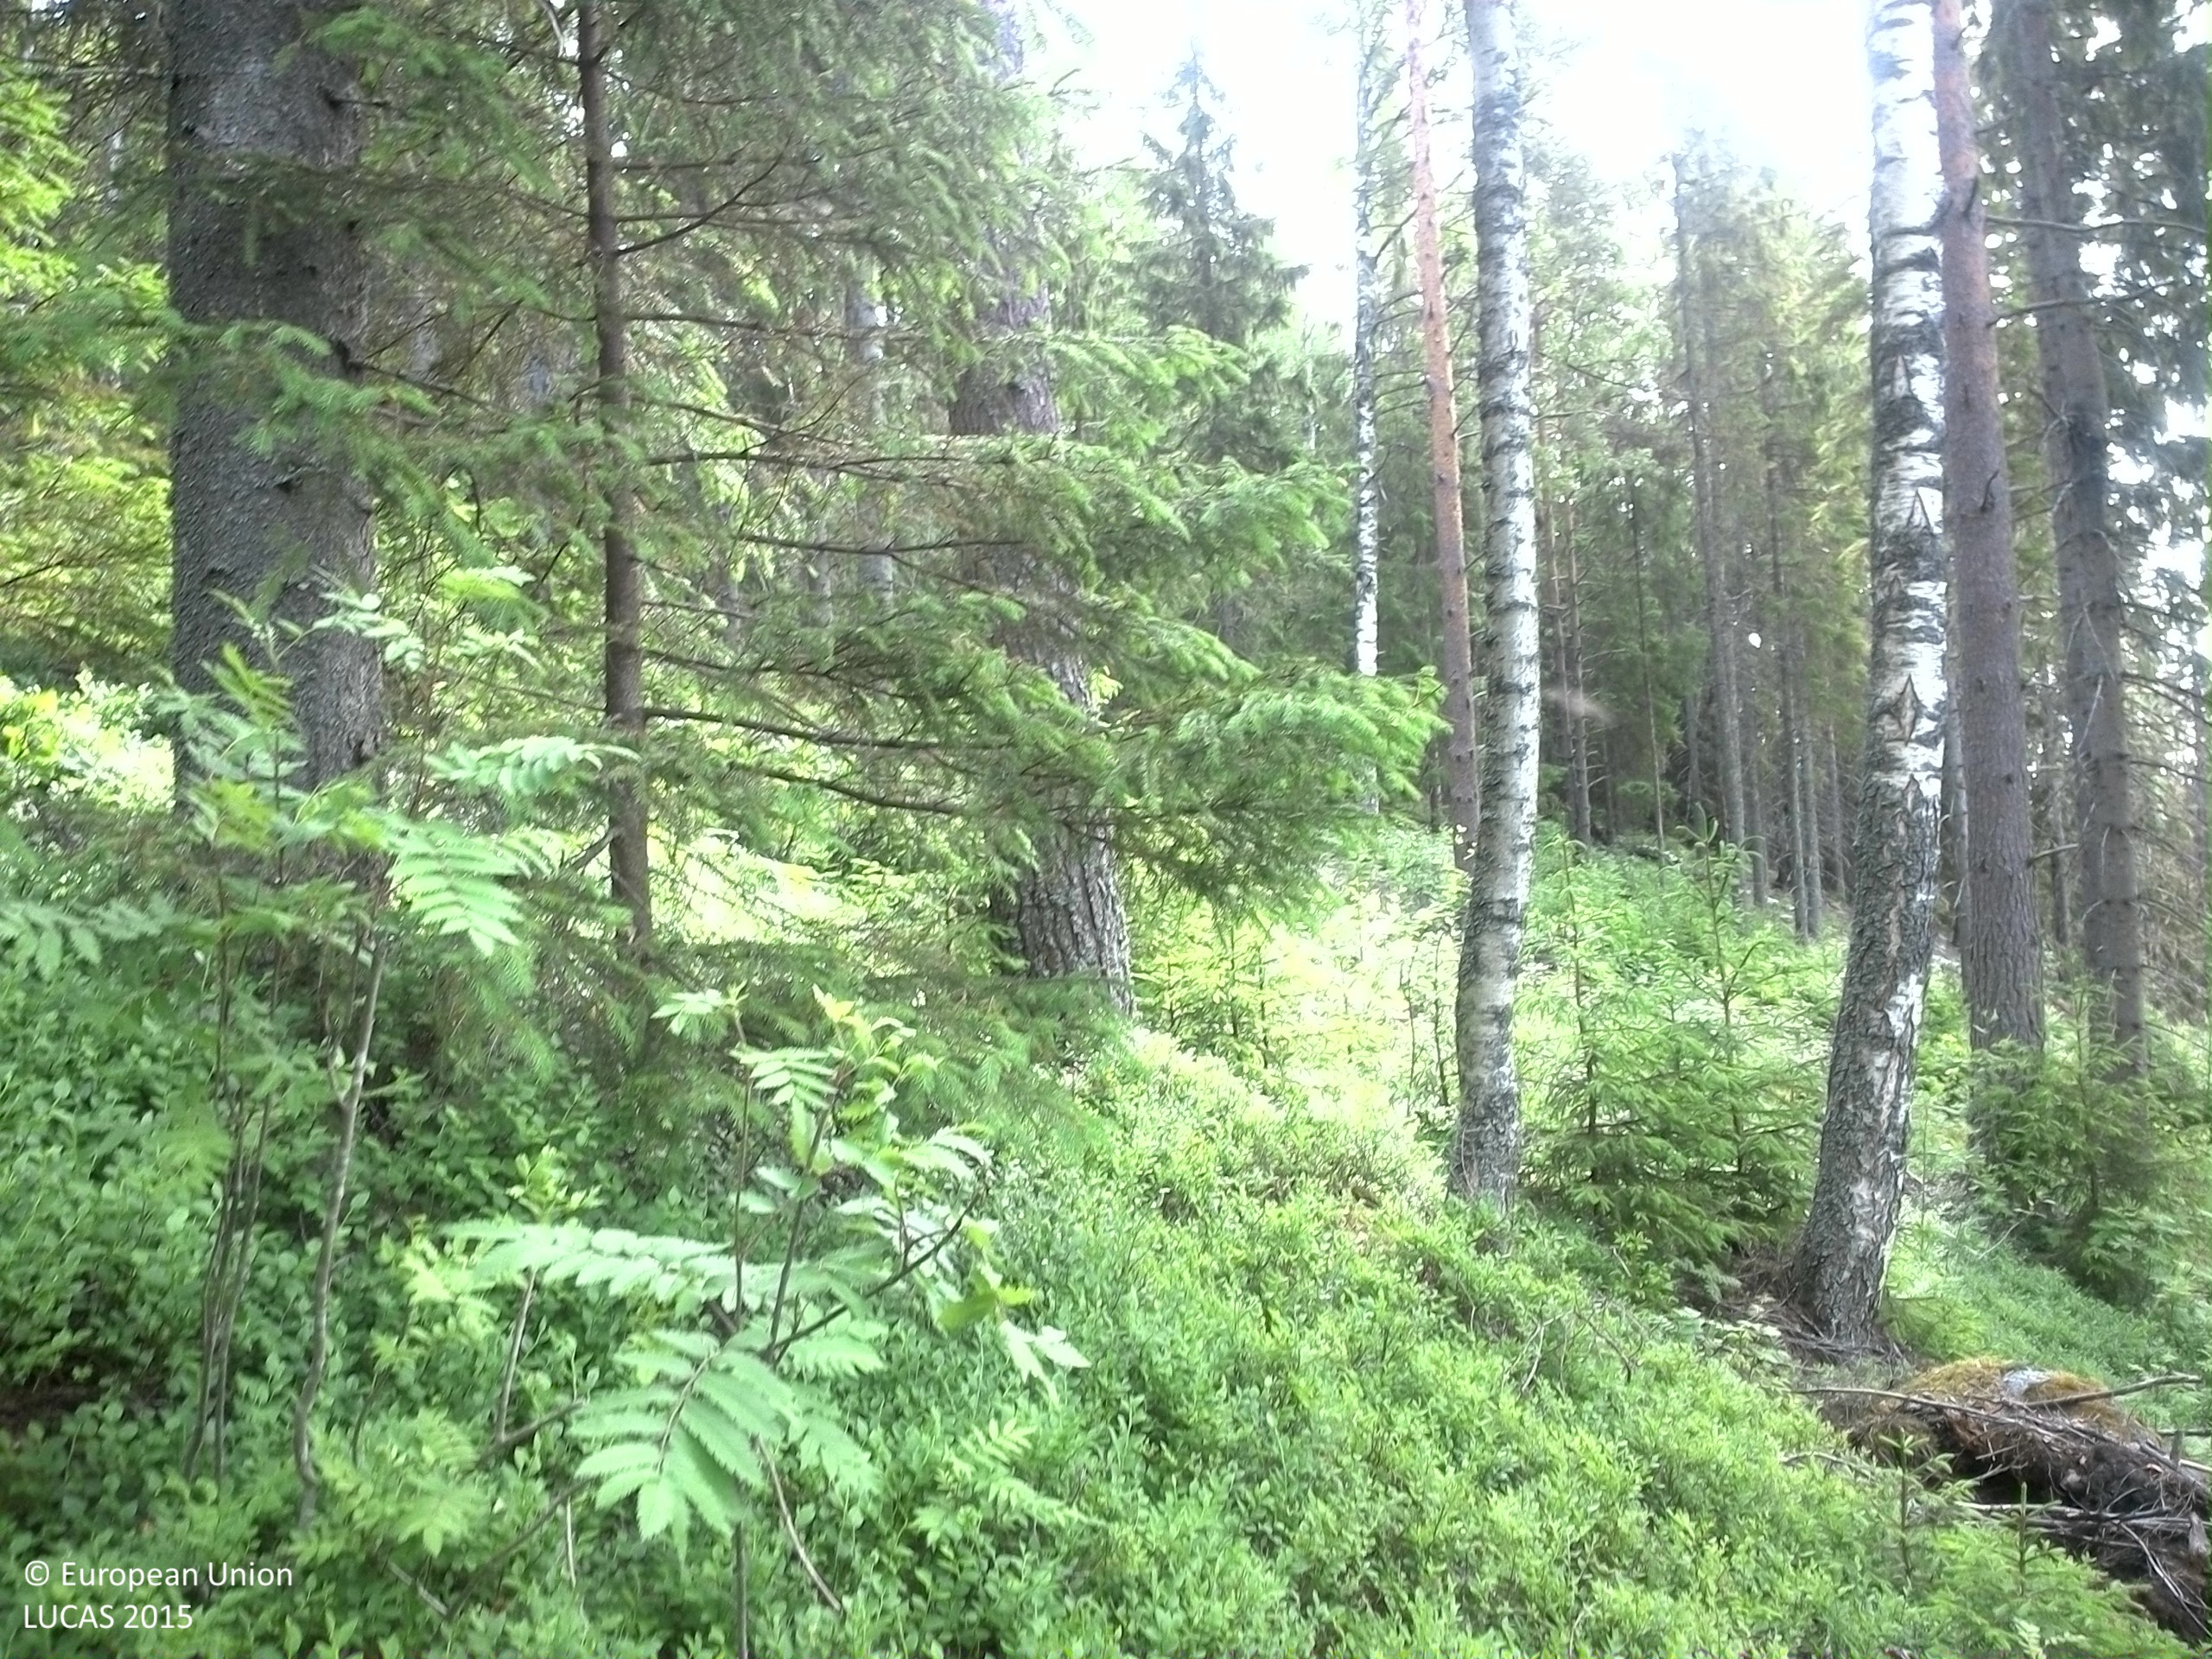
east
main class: Woodland
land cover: Spruce dominated mixed woodland
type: boreal forest
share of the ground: 50 - 75 %
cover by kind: shrubs 45 %, coniferous forest trees 40 %, broadleaved forest trees 15 %
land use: Forestry
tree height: > 5 m
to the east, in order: Spruce dominated mixed woodland; Spruce dominated coniferous woodland
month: June
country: SE
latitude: 62.8445
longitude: 17.8148
